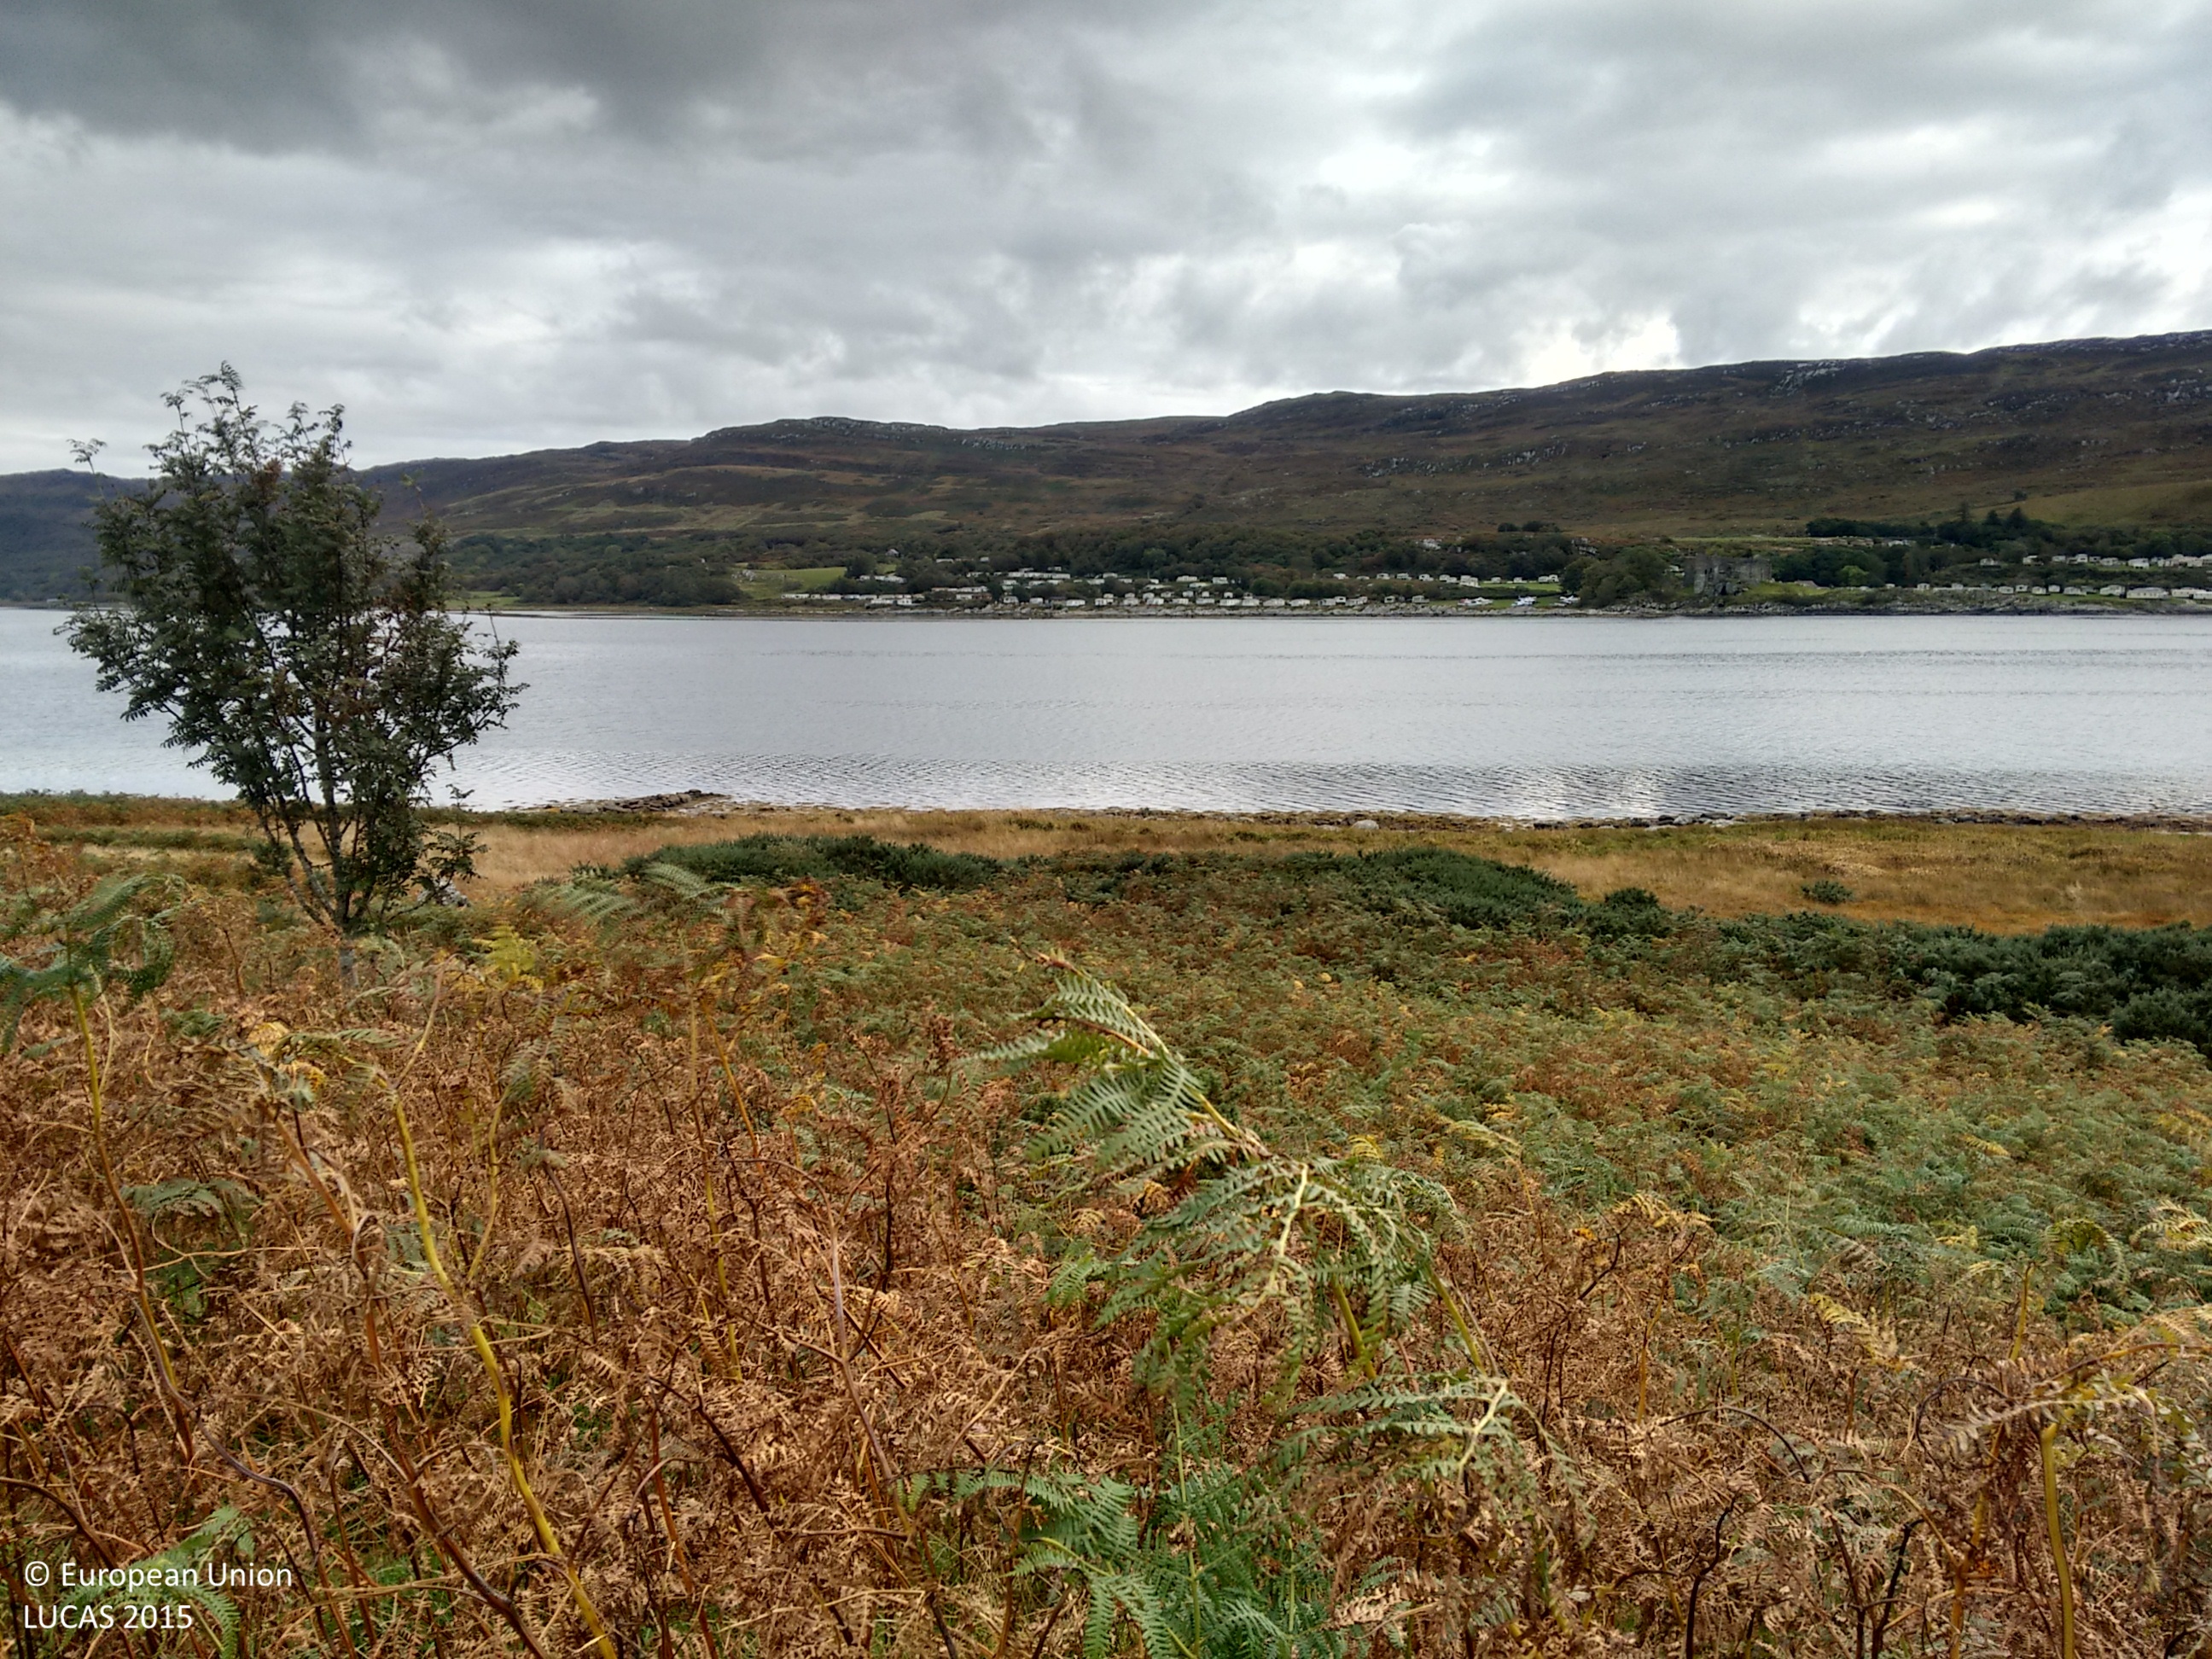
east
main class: Shrubland
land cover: Shrubland with sparse tree cover
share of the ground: > 75 %
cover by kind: shrubs 85 %, herbaceous plants 10 %, broadleaved forest trees 5 %
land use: Agriculture (excluding fallow land and kitchen gardens)
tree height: < 5 m
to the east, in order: Shrubland with sparse tree cover; Shrubland without tree cover; Grassland without tree/shrub cover; Sand; Transitional water bodies
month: October
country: GB
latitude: 55.9496
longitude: -5.6767
